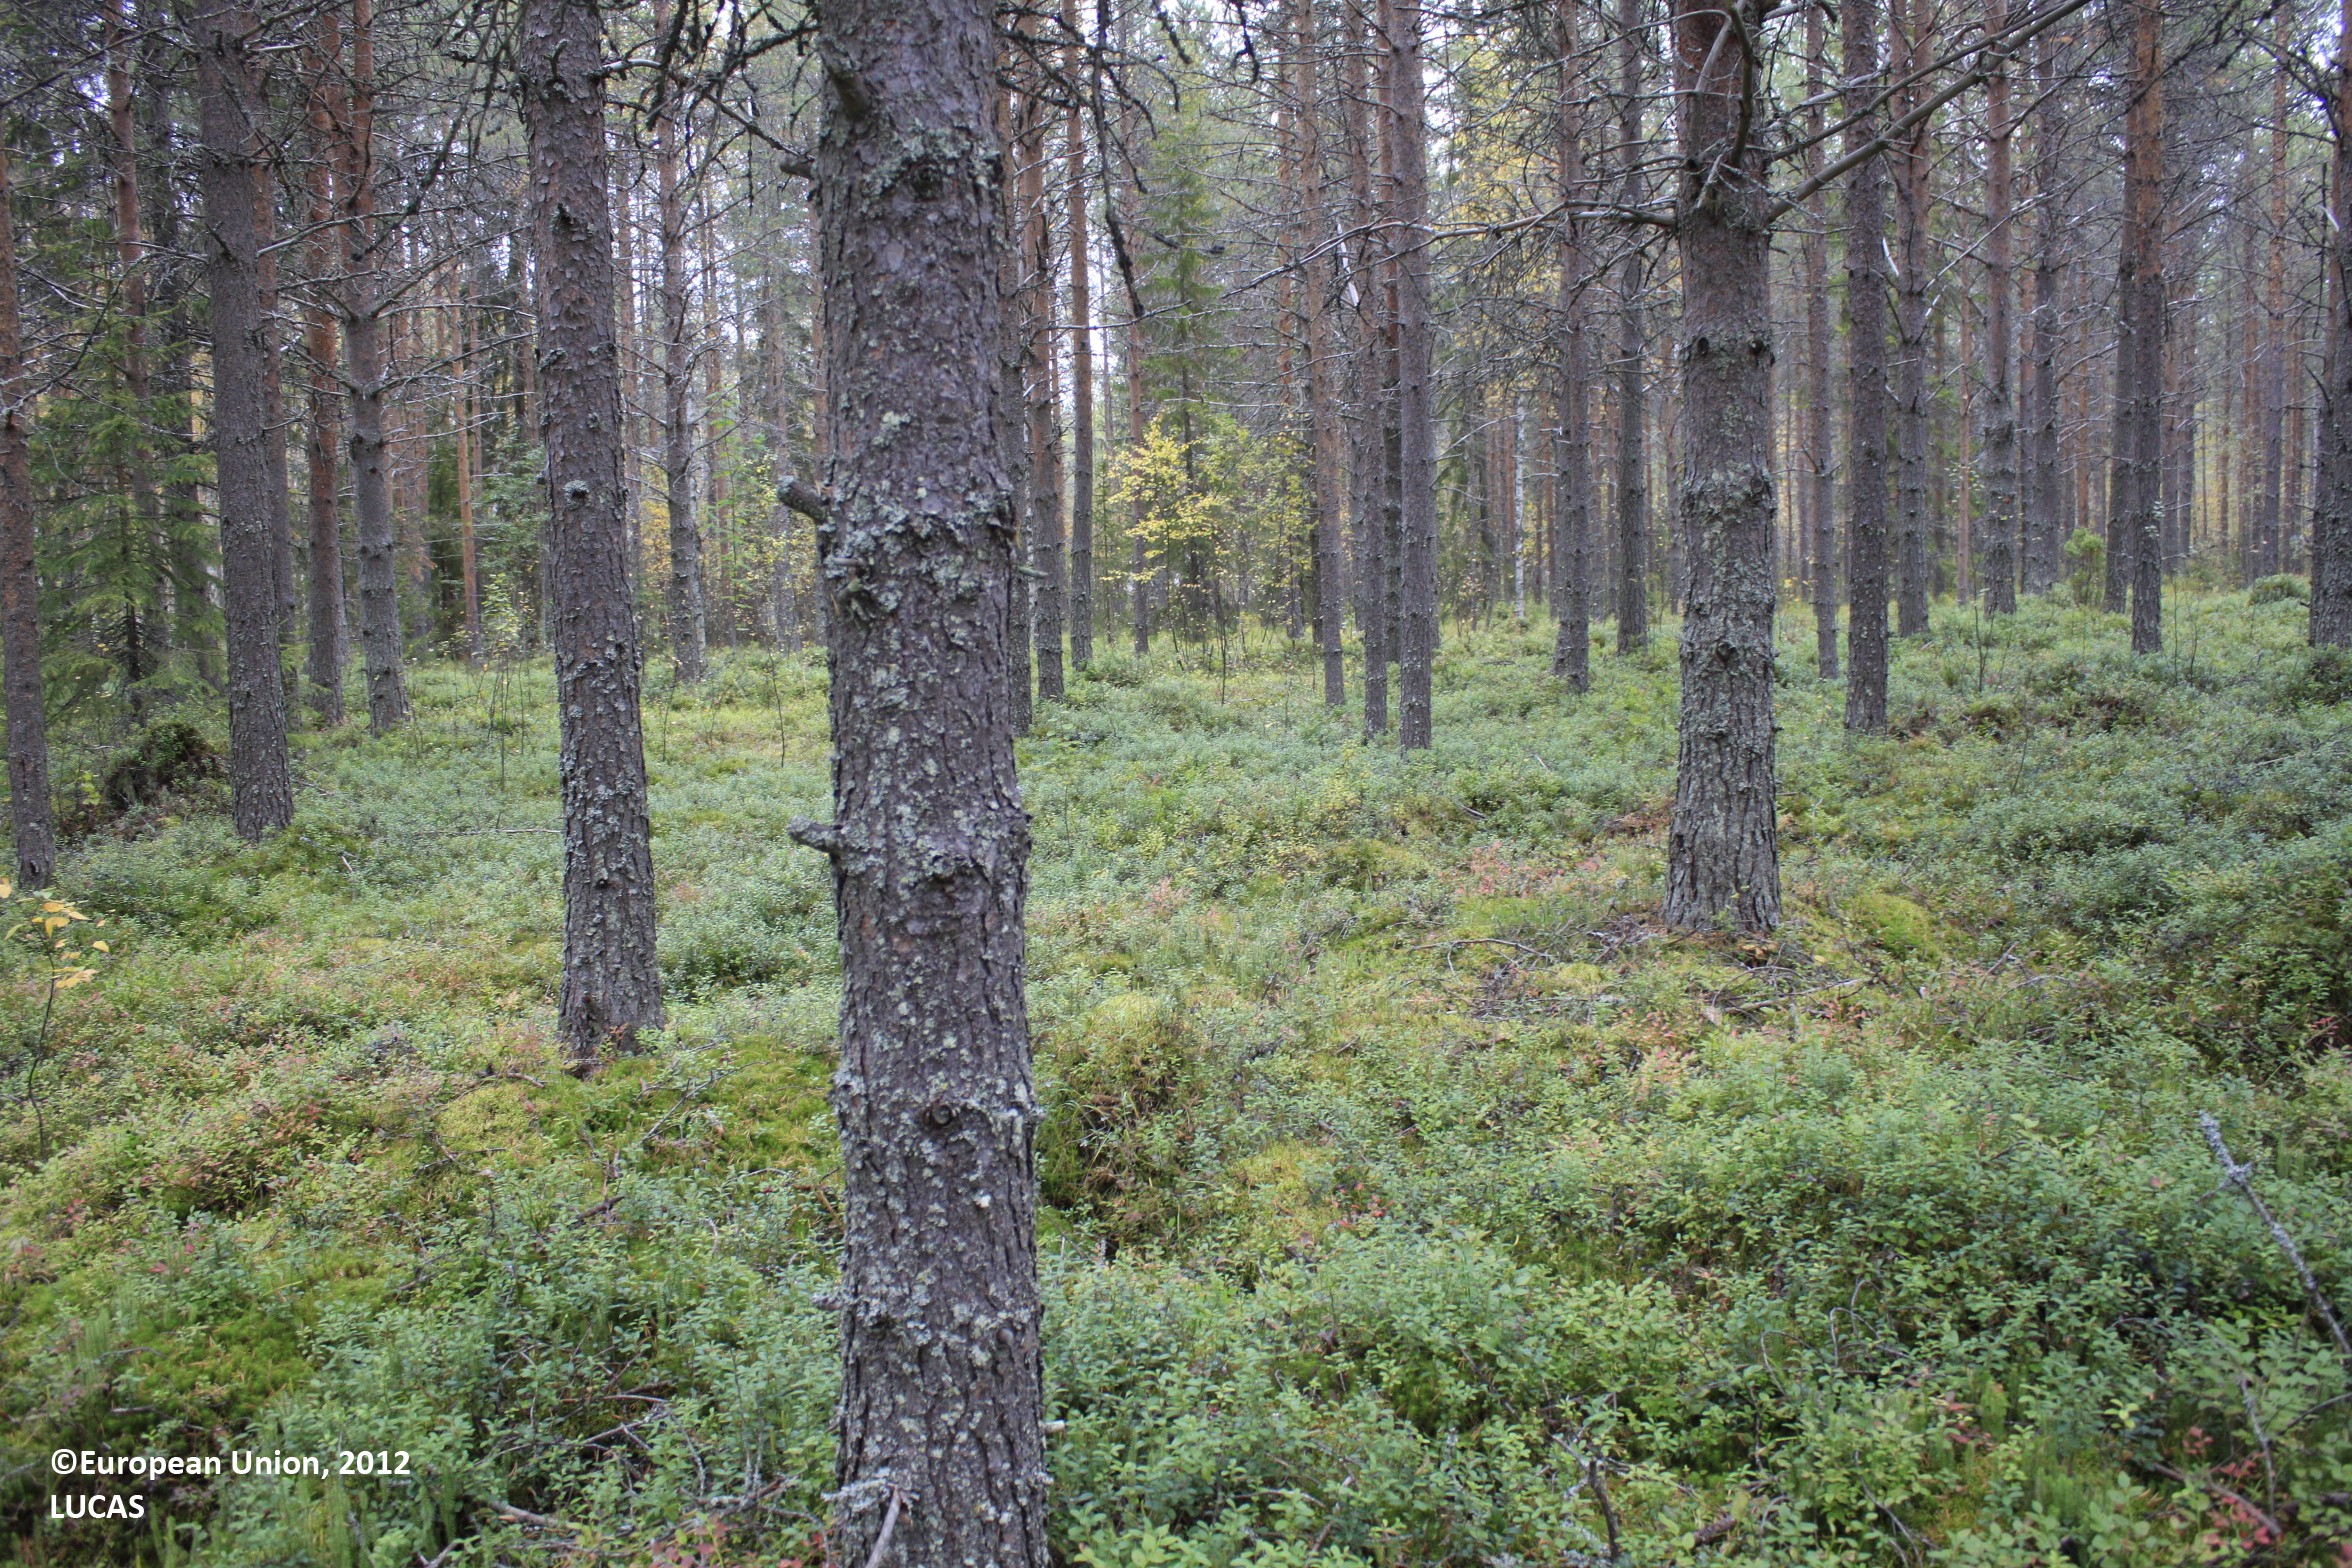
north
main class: Woodland
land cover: Pine dominated coniferous woodland
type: boreal forest
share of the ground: 50 - 75 %
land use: Forestry
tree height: > 5 m
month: September
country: FI
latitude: 65.5451
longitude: 27.2451
